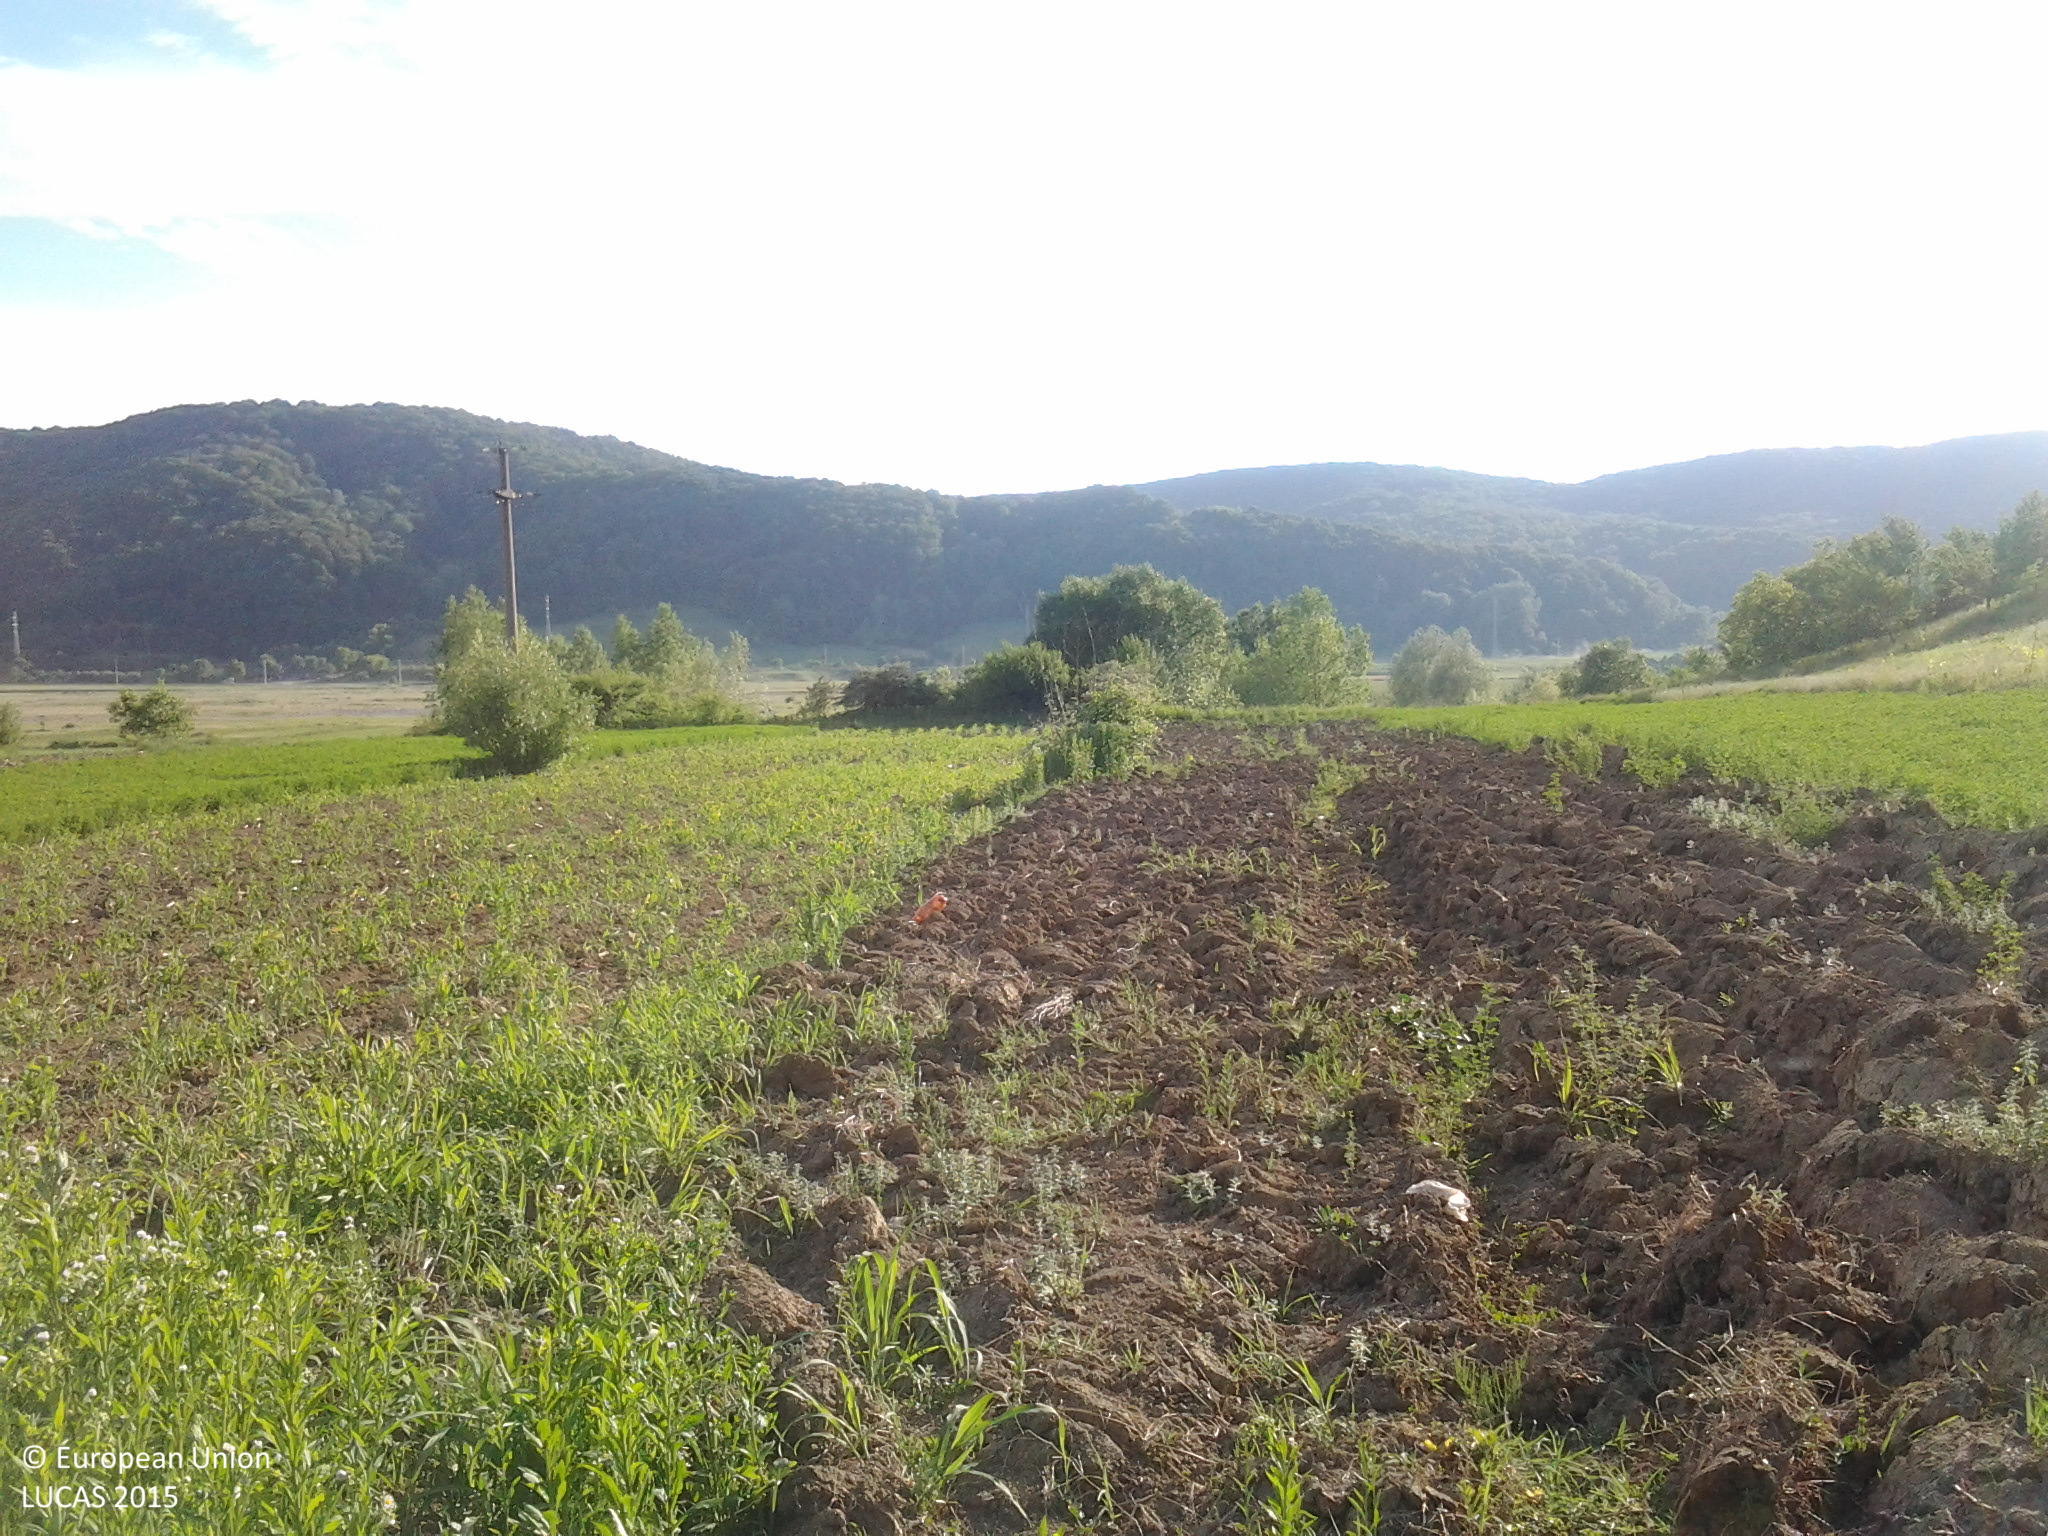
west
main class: Cropland
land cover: Vineyards
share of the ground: > 75 %
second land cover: Grassland without tree/shrub cover
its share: < 10 %
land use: Agriculture (excluding fallow land and kitchen gardens)
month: June
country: RO
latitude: 46.3621
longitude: 26.7372
